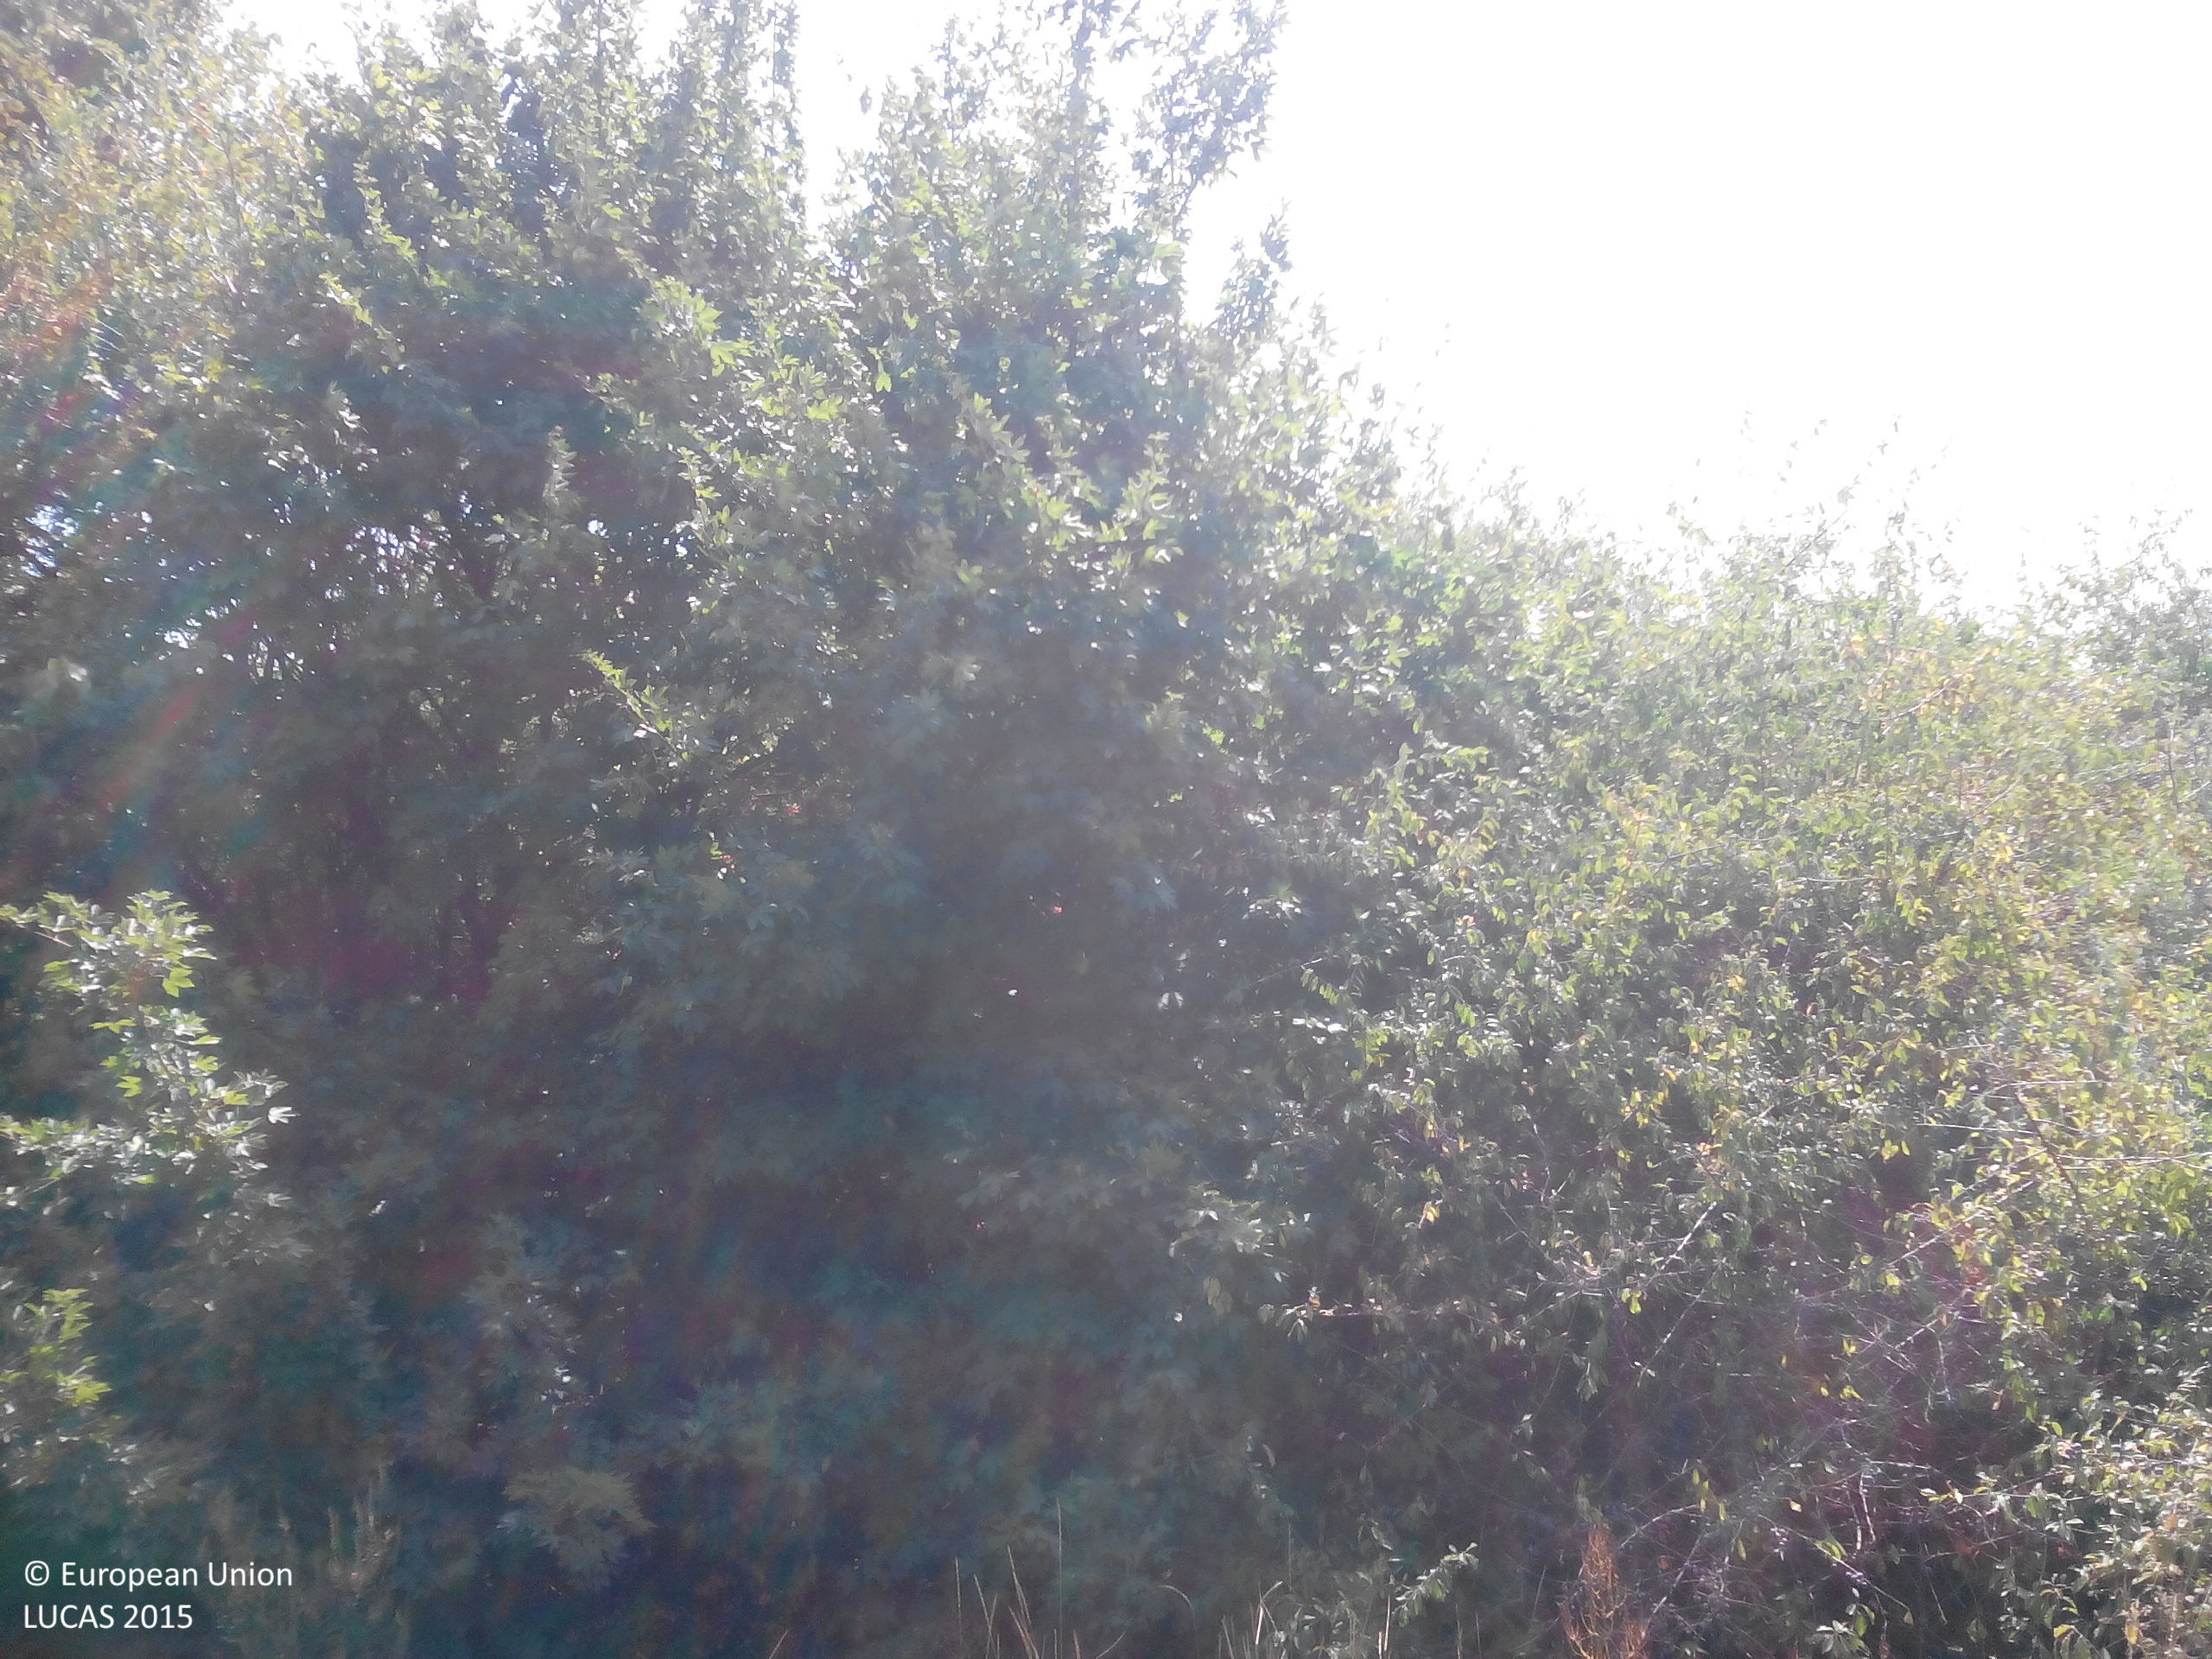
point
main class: Woodland
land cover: Broadleaved woodland
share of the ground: 50 - 75 %
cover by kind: broadleaved forest trees 75 %, shrubs 15 %, herbaceous plants 10 %
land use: Semi-natural and natural areas not in use
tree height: > 5 m
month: August
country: BG
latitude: 43.3905
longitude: 23.6378
